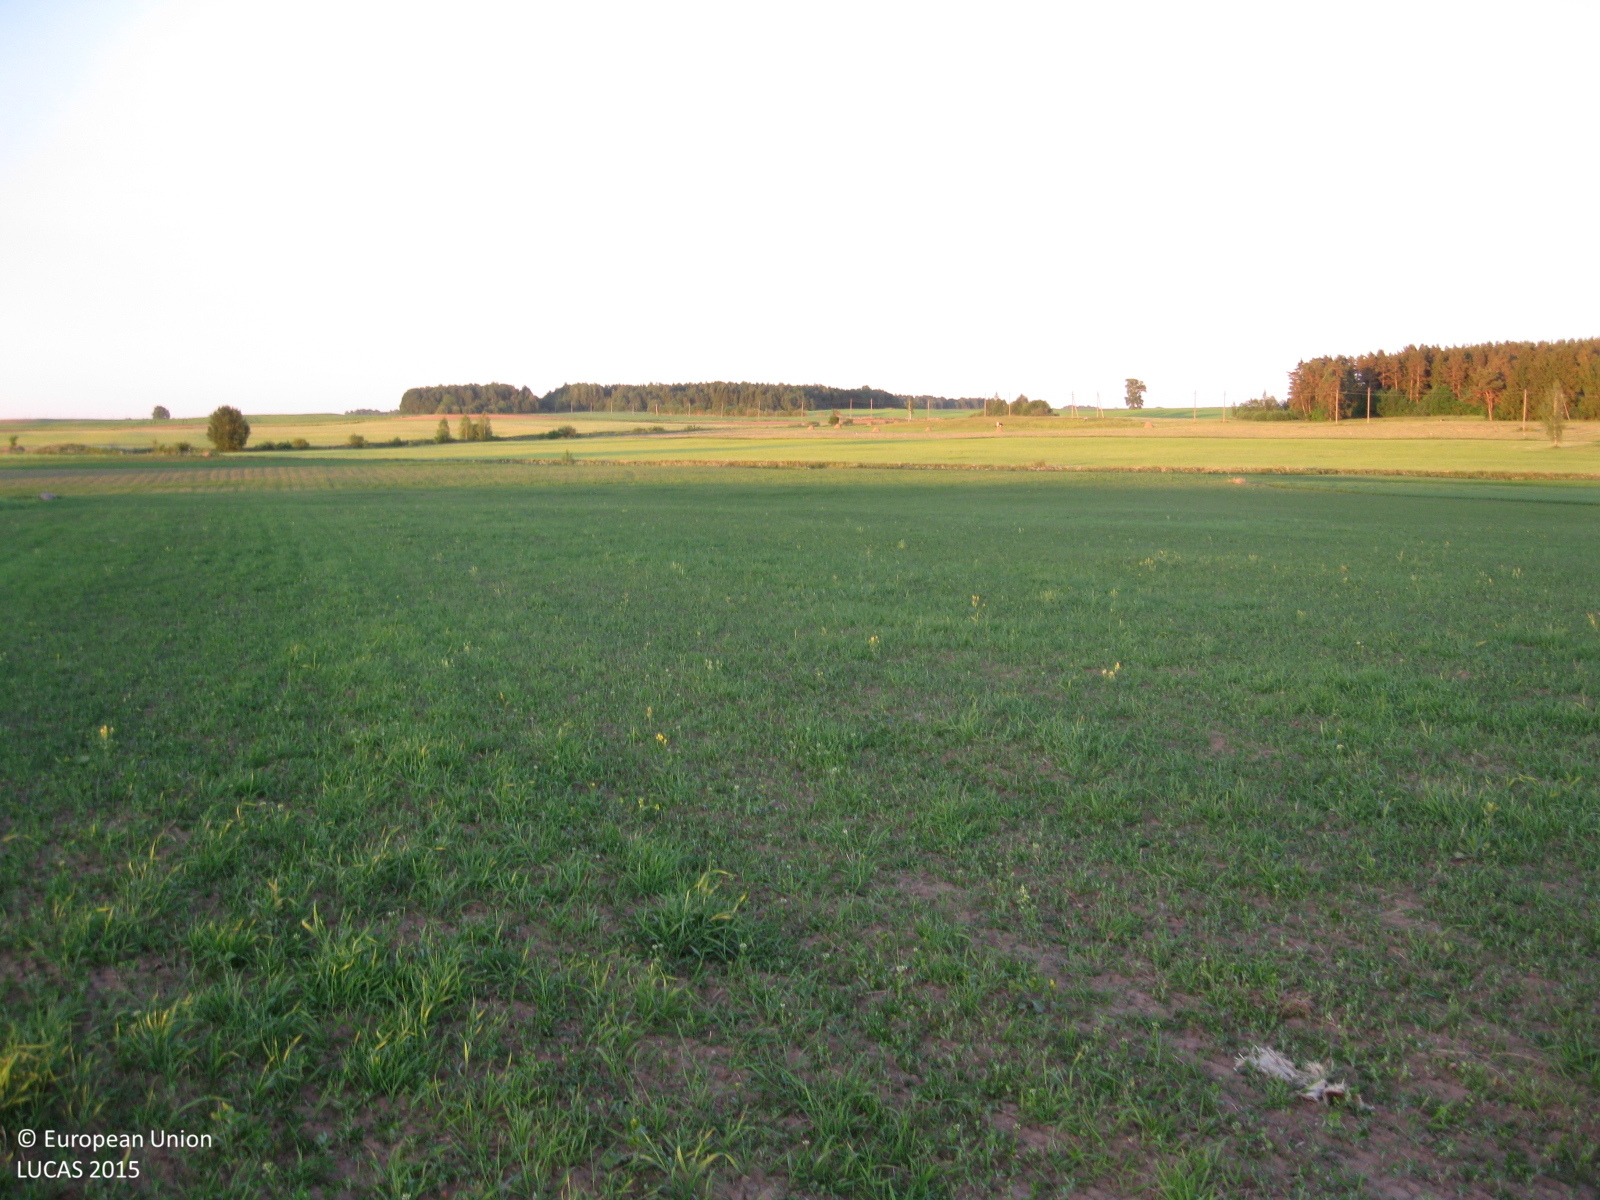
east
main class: Cropland
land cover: Rape and turnip rape
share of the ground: 25 - 50 %
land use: Agriculture (excluding fallow land and kitchen gardens)
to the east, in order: Rape and turnip rape; Dry pulses; Spontaneously vegetated surfaces; Ditches and canals; Spontaneously vegetated surfaces; Grassland without tree/shrub cover
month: June
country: LT
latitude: 55.5049
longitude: 23.6829
